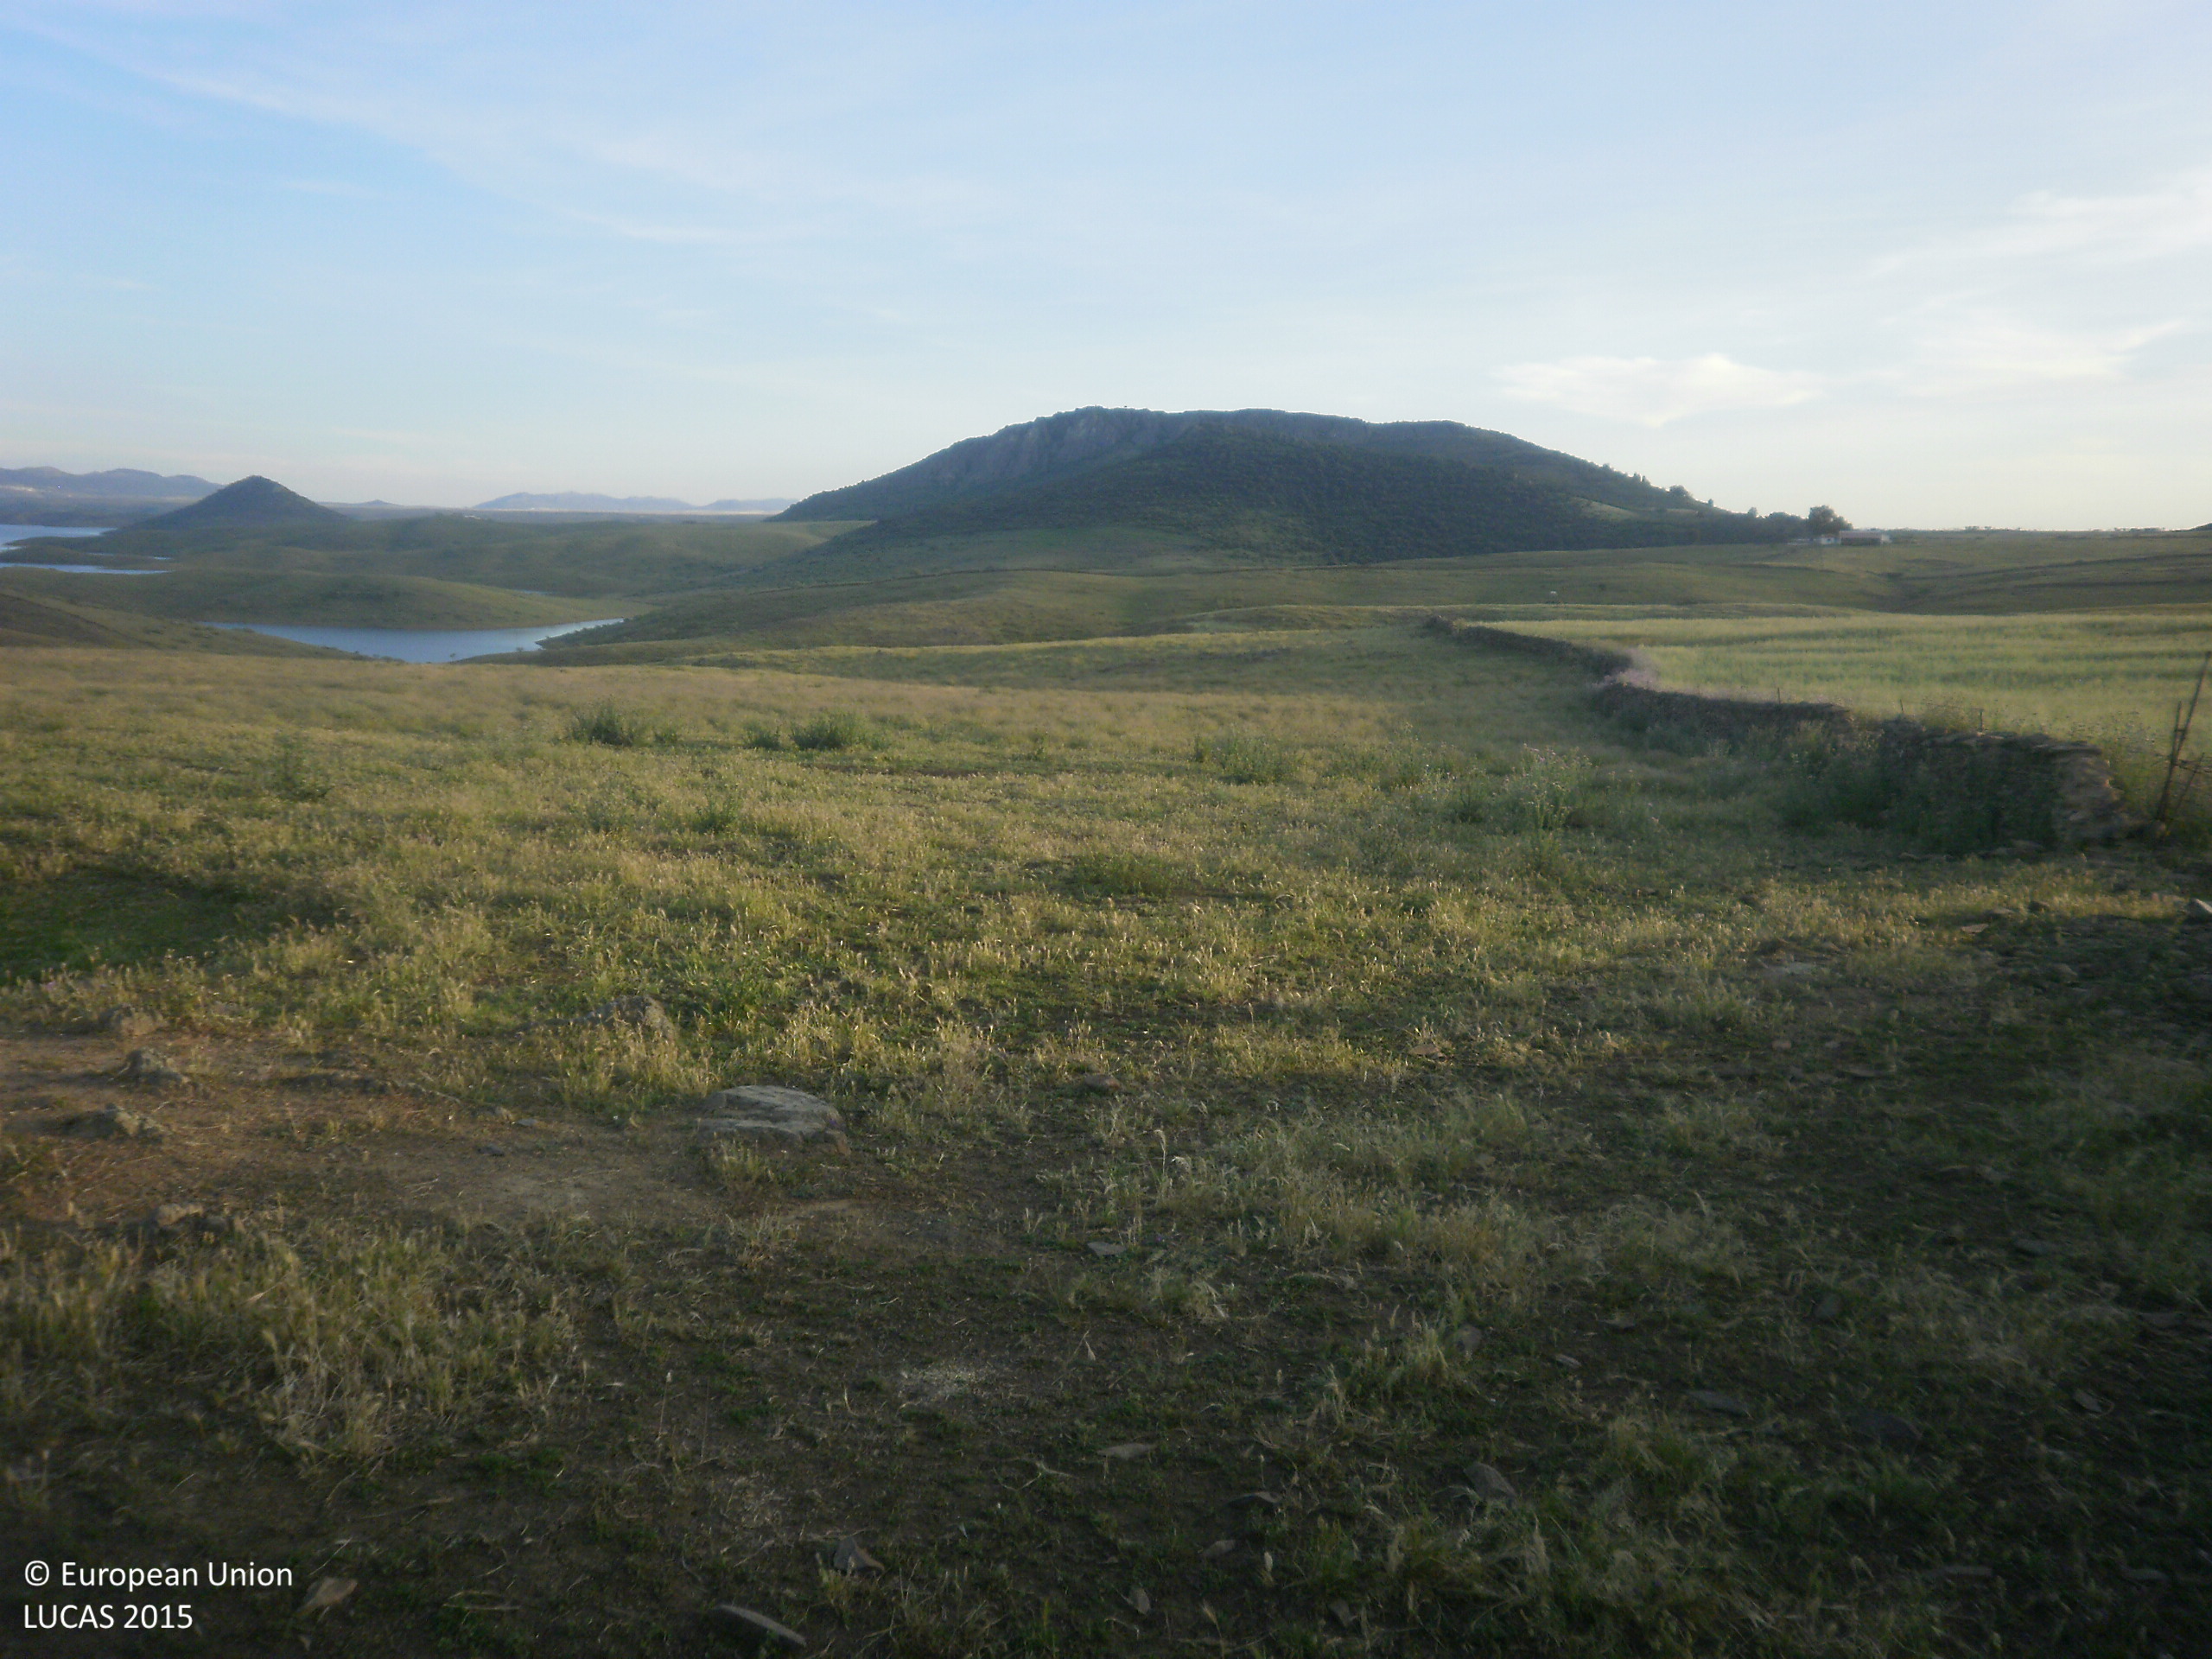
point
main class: Grassland
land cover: Grassland without tree/shrub cover
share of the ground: > 75 %
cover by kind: herbaceous plants 100 %
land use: Agriculture (excluding fallow land and kitchen gardens)
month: April
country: ES
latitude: 38.9804
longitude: -5.2185
